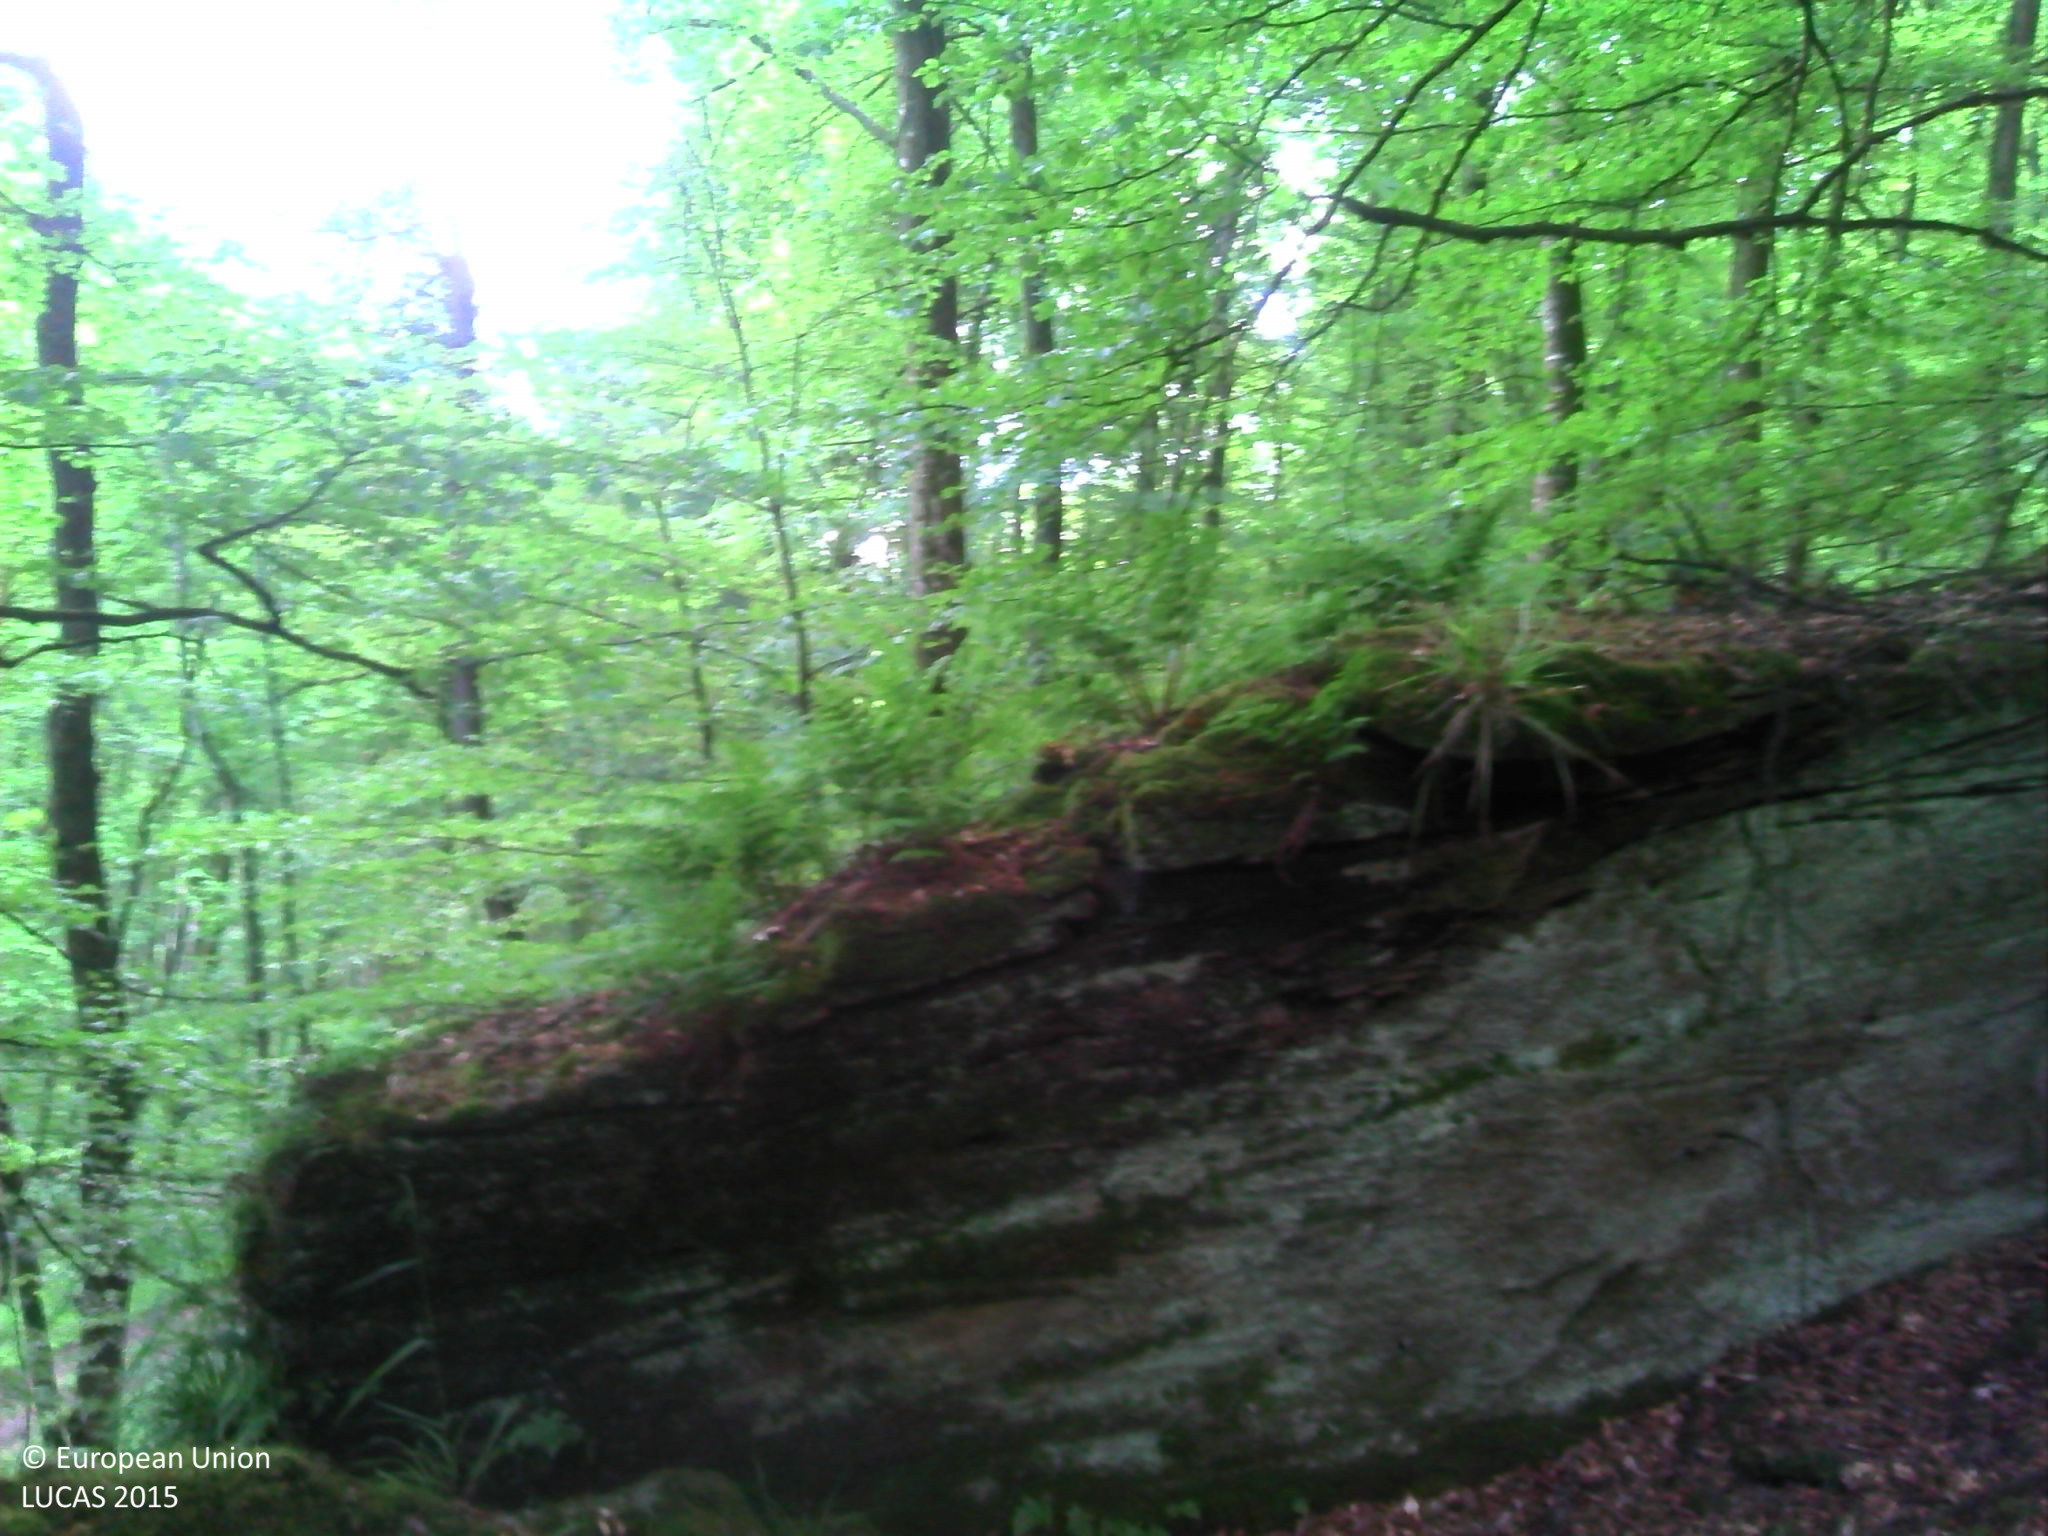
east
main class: Woodland
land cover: Broadleaved woodland
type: acidophilous oak and oak-birch forest
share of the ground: > 75 %
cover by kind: broadleaved forest trees 75 %, herbaceous plants 20 %, lichens and mosses 5 %
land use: Forestry
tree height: > 5 m
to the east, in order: Broadleaved woodland; Grass margins; Tracks; Grass margins; Broadleaved woodland; Spruce dominated mixed woodland; Rivers and streams; Other mixed woodland
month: May
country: LU
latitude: 49.8385
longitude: 6.3706
